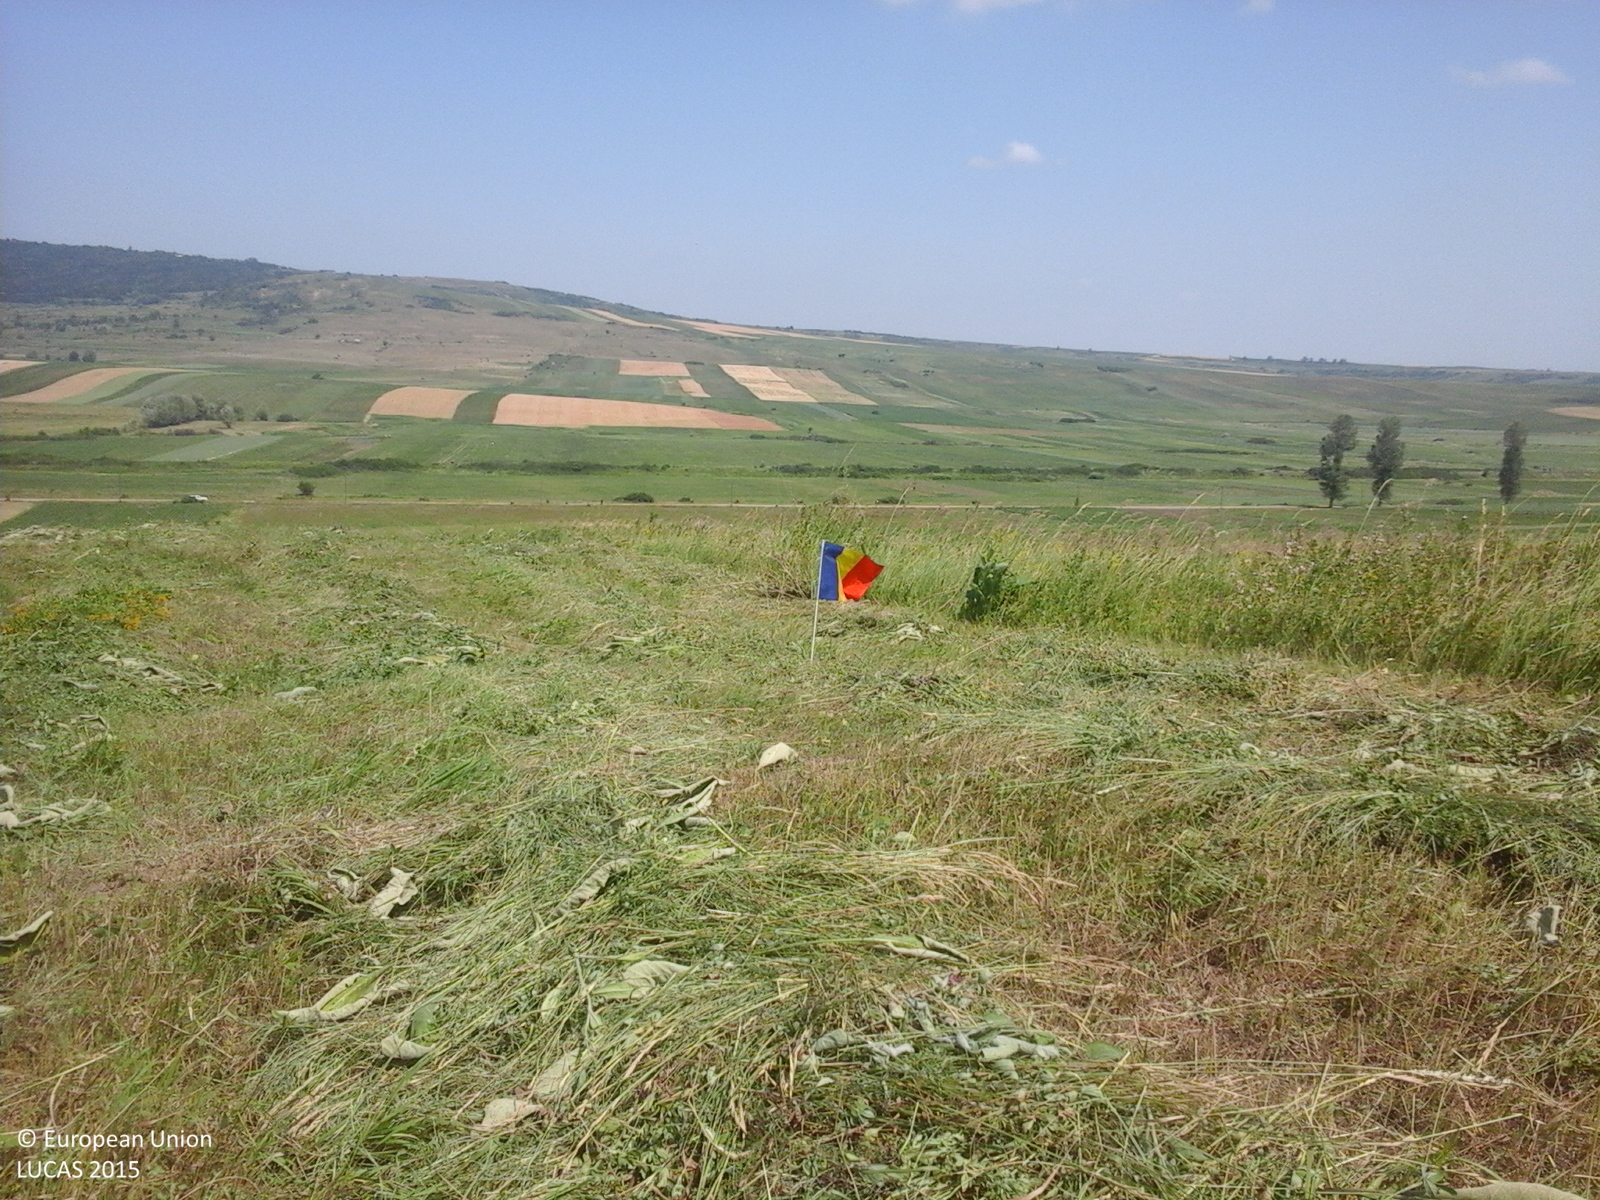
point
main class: Grassland
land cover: Grassland without tree/shrub cover
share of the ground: > 75 %
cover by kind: herbaceous plants 100 %
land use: Agriculture (excluding fallow land and kitchen gardens)
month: June
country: RO
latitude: 46.8936
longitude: 27.2070
